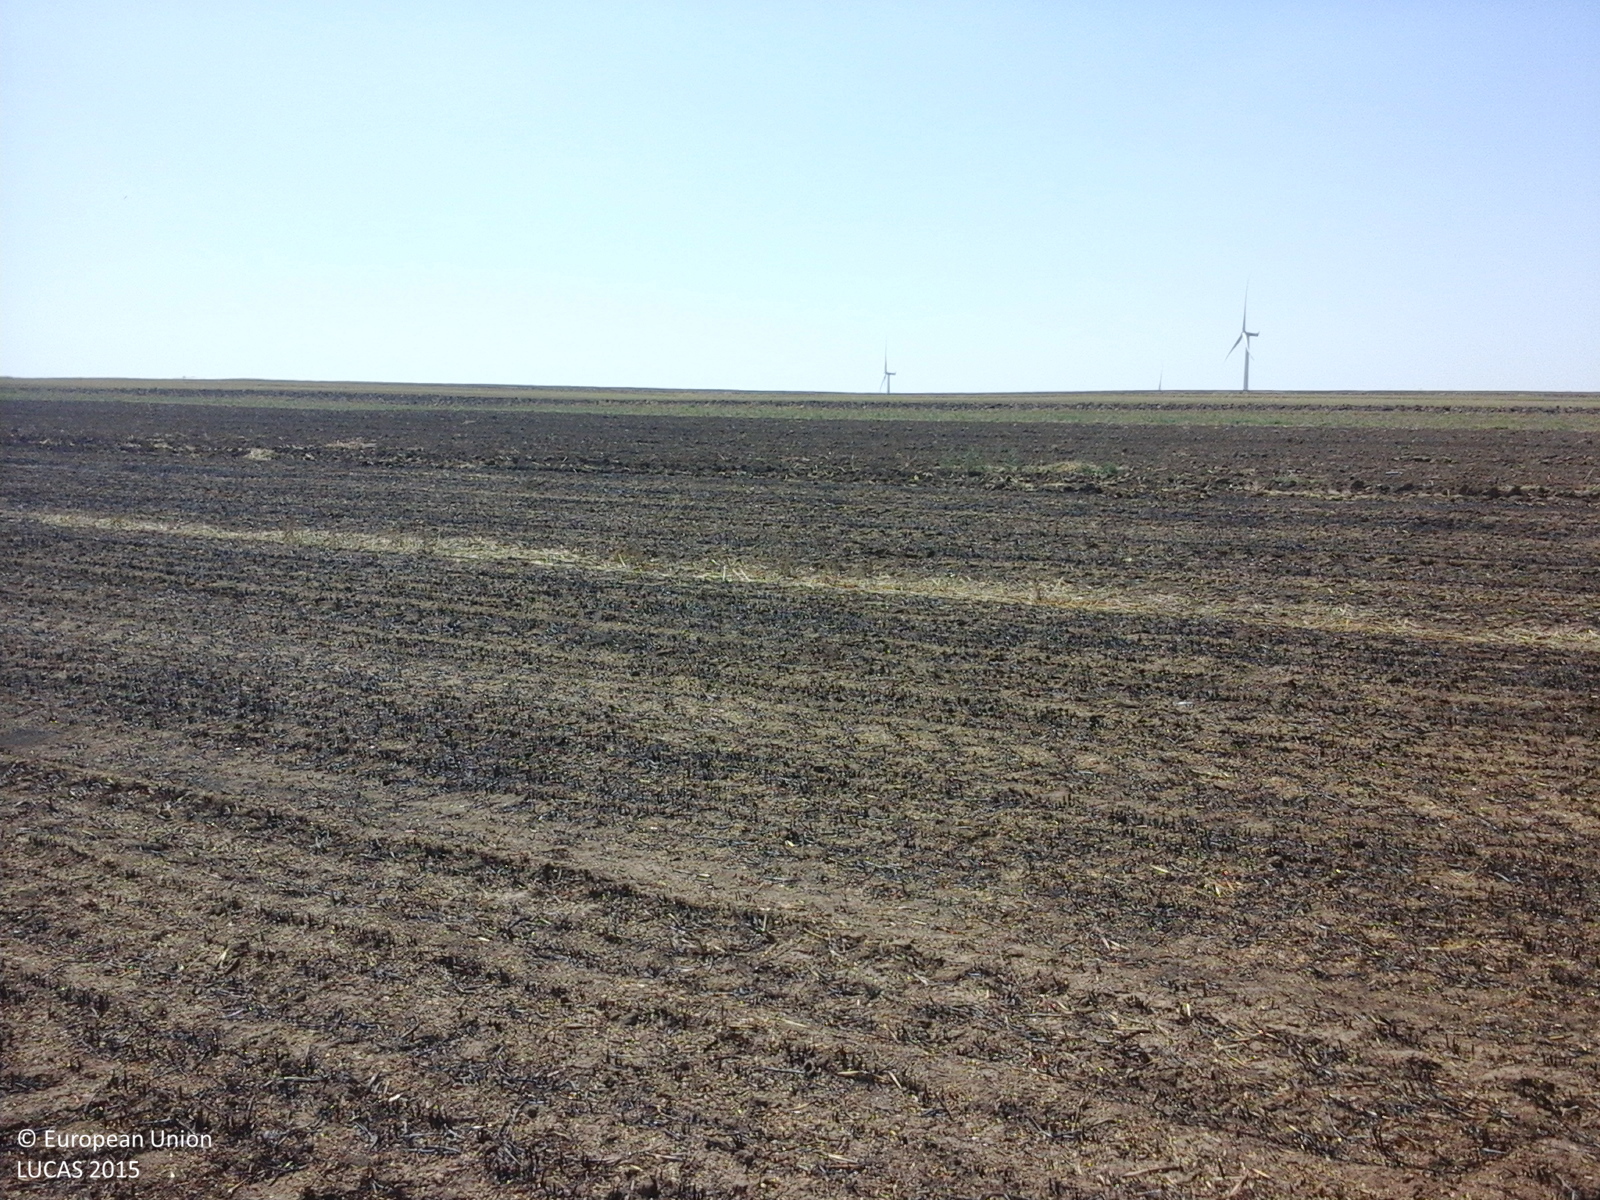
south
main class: Cropland
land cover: Common wheat
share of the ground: < 10 %
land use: Agriculture (excluding fallow land and kitchen gardens)
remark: Burnt area
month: August
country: RO
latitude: 44.3718
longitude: 28.3775
